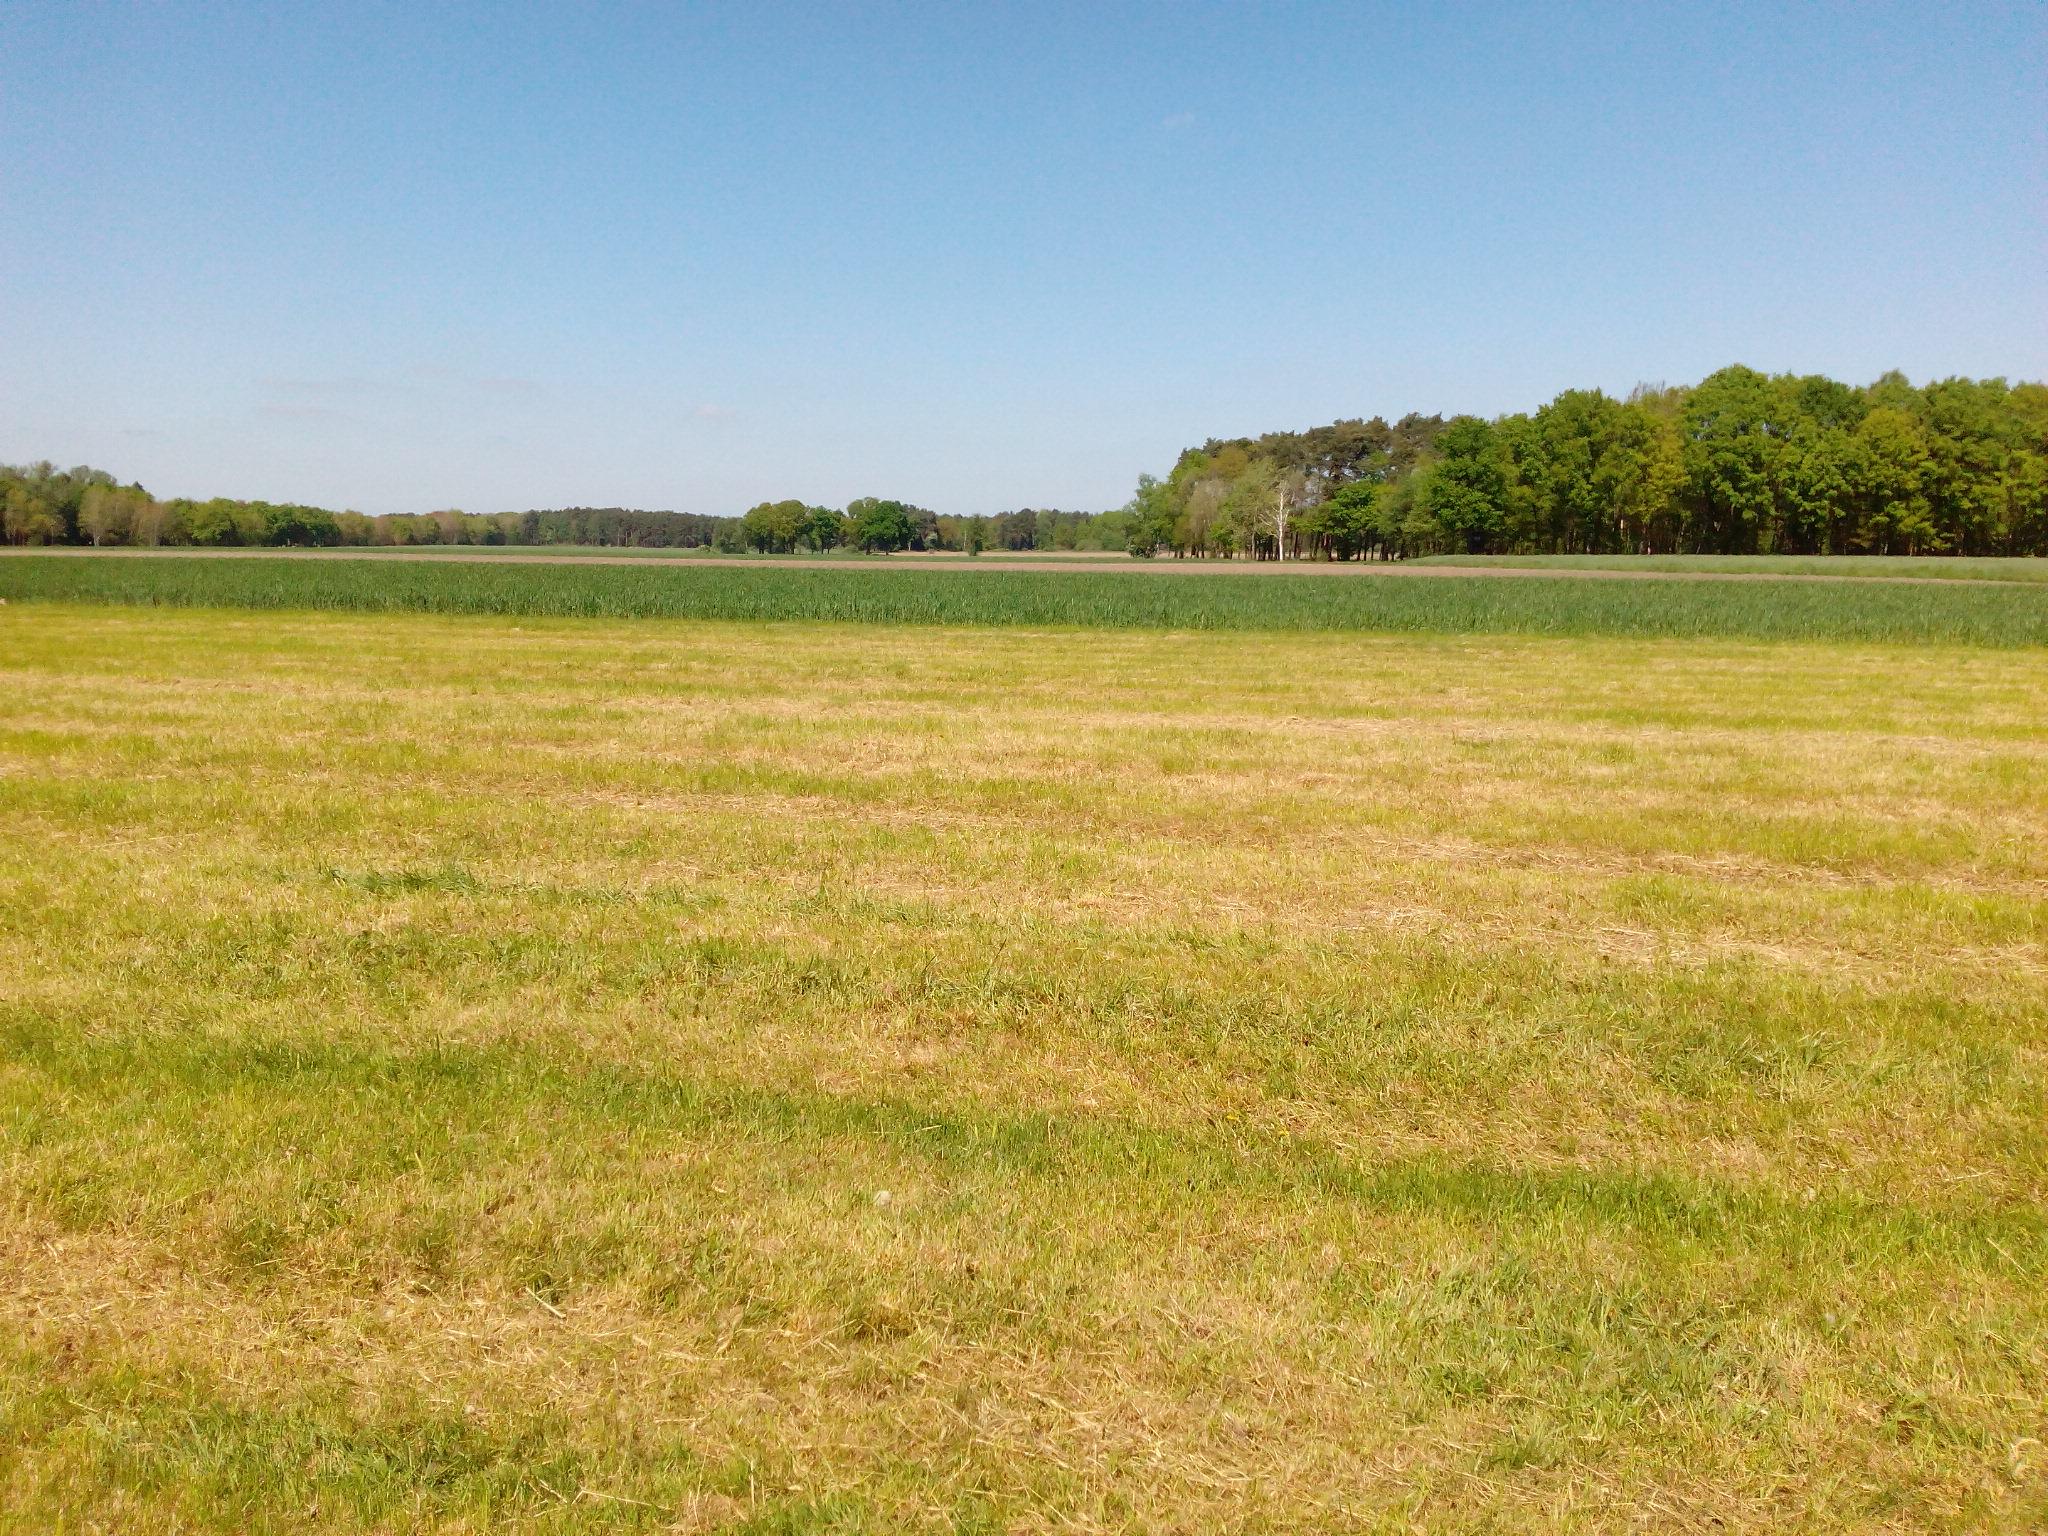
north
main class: Grassland
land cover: Grassland without tree/shrub cover
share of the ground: > 75 %
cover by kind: herbaceous plants 100 %
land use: Agriculture (excluding fallow land and kitchen gardens)
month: May
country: DE
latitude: 52.4846
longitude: 9.6026
